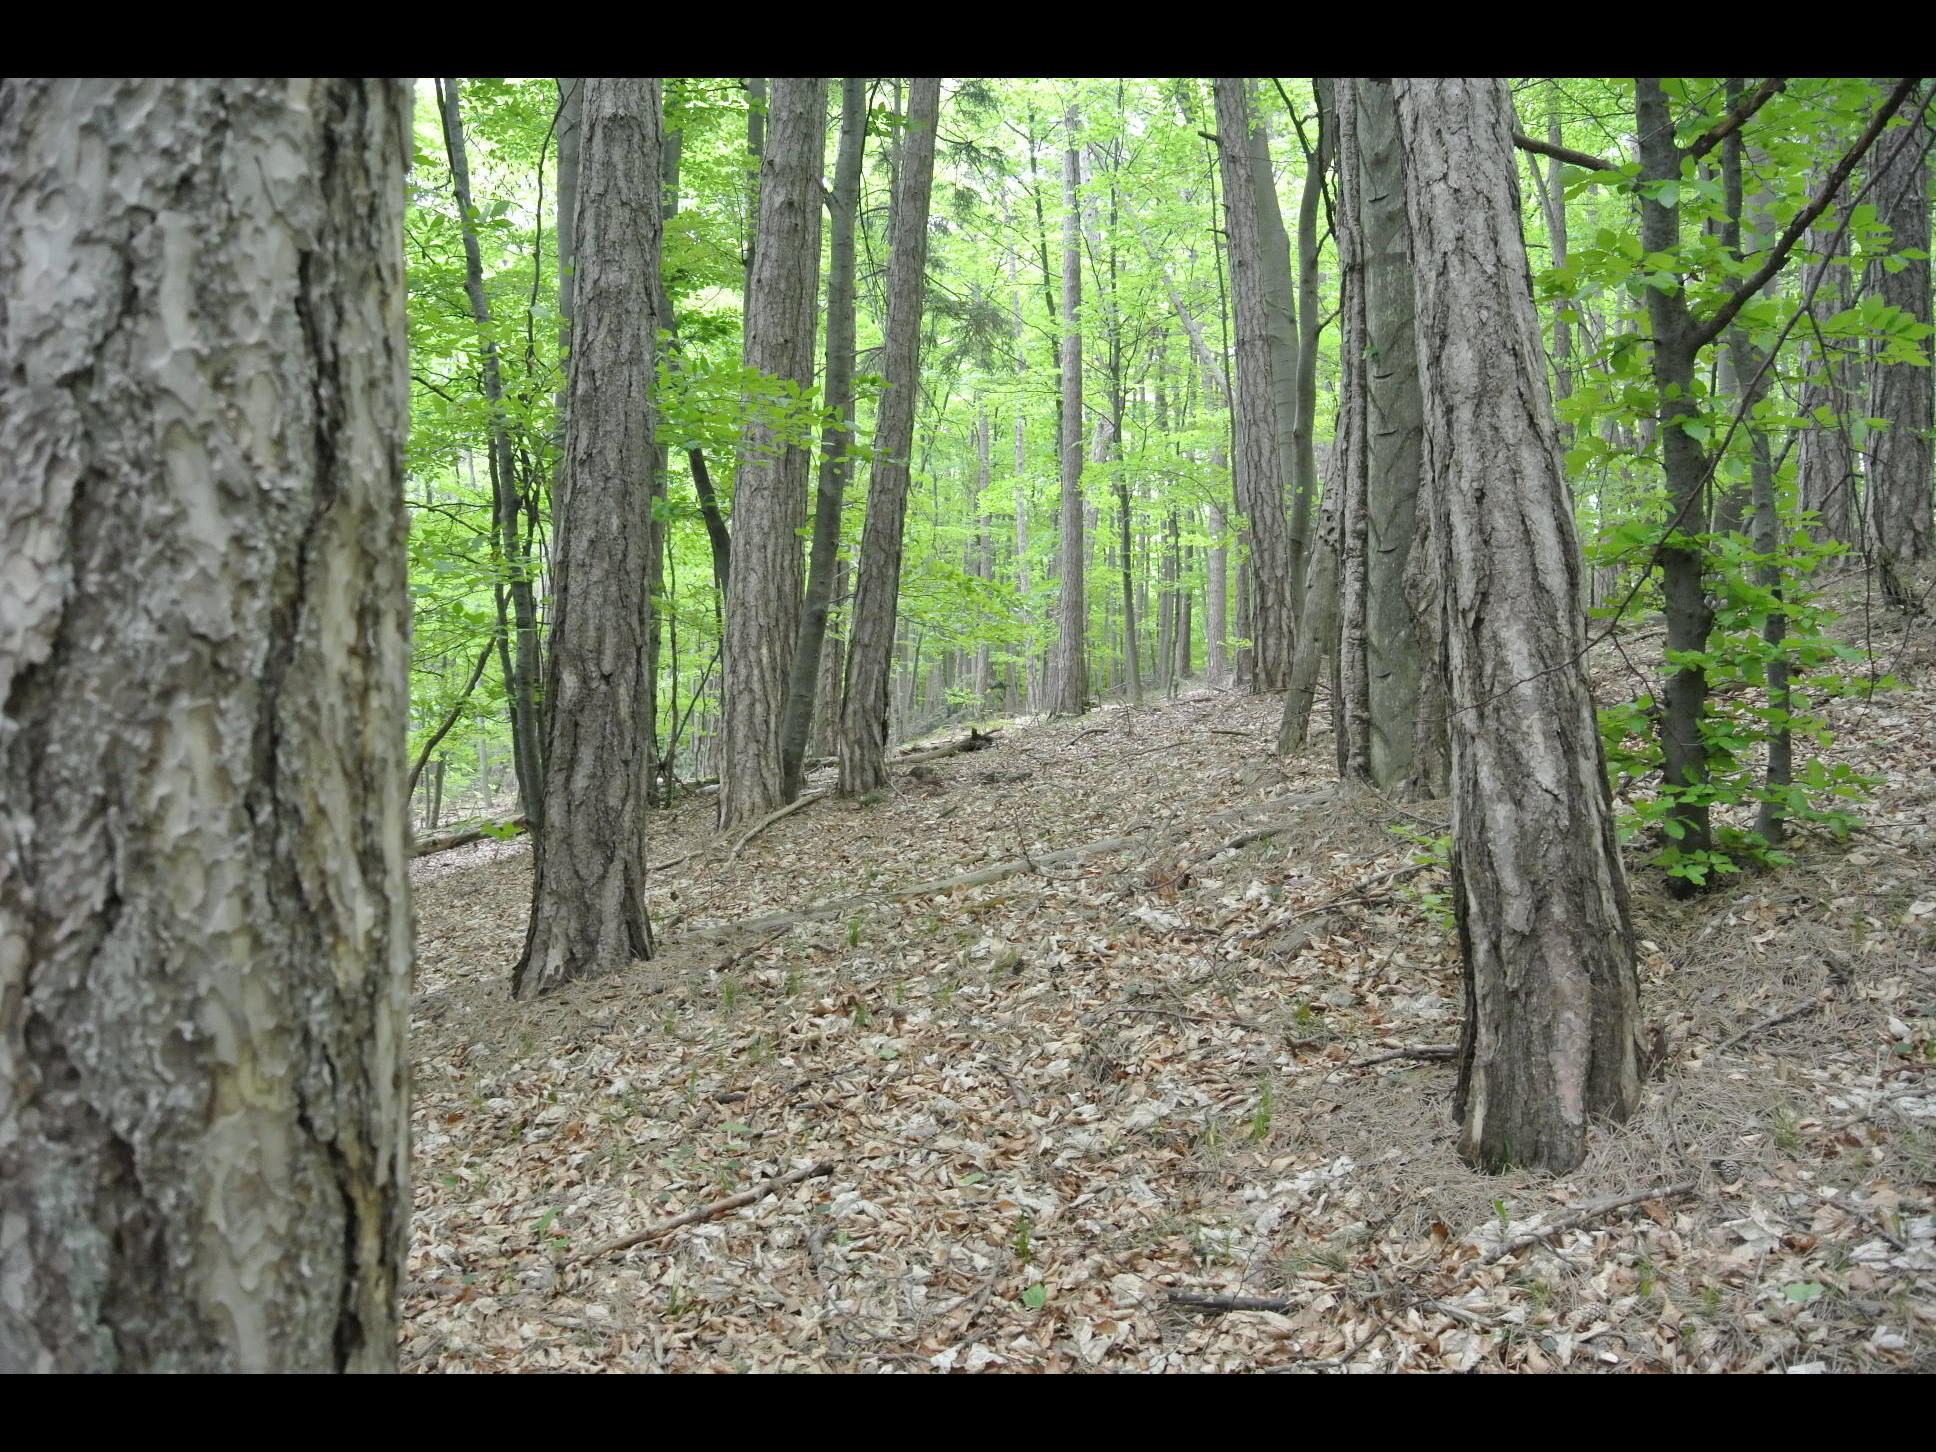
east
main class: Woodland
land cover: Pine dominated mixed woodland
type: alpine coniferous forest
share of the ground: > 75 %
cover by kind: coniferous forest trees 50 %, broadleaved forest trees 50 %
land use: Forestry
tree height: > 5 m
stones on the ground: < 10 %
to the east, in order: Pine dominated mixed woodland; Tracks; Broadleaved woodland; Pine dominated mixed woodland
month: May
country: AT
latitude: 47.9675
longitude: 16.0442
